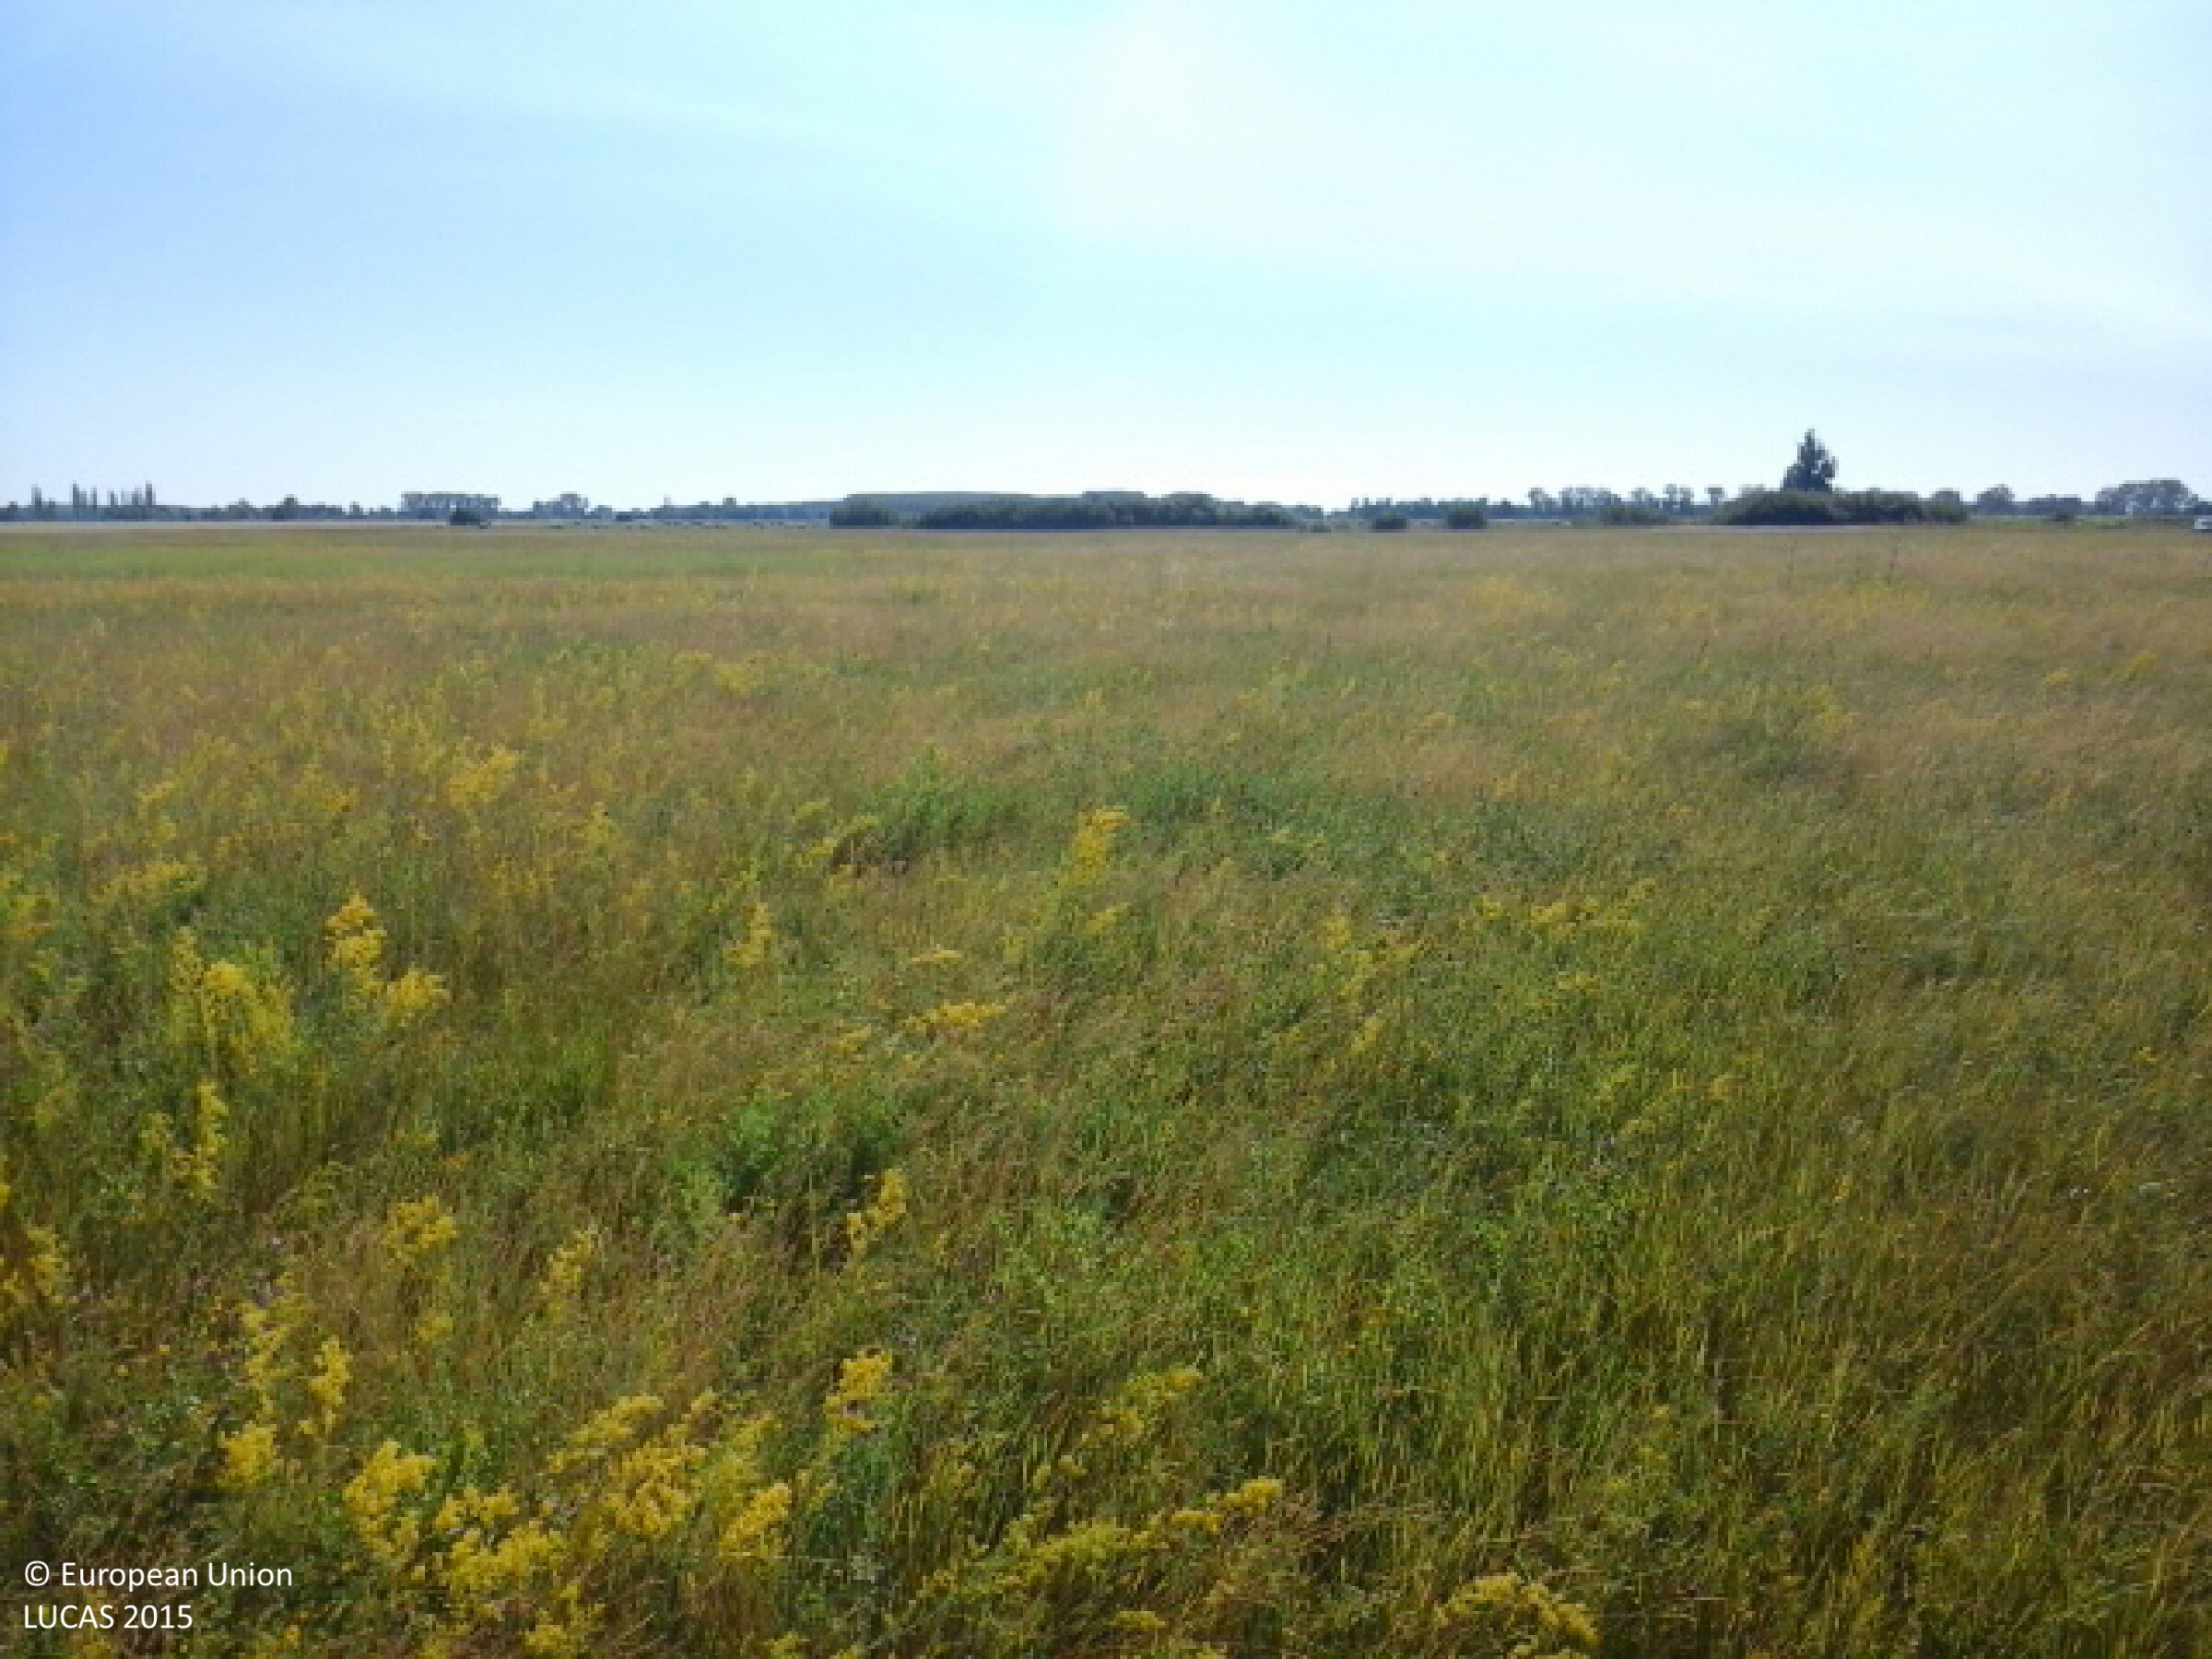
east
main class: Grassland
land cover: Grassland without tree/shrub cover
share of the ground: > 75 %
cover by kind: herbaceous plants 100 %
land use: Semi-natural and natural areas not in use
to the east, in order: Grassland without tree/shrub cover; Tracks; Managed hedges; Ditches and canals; Spontaneously vegetated surfaces
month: July
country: HU
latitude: 48.2313
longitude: 21.5575
